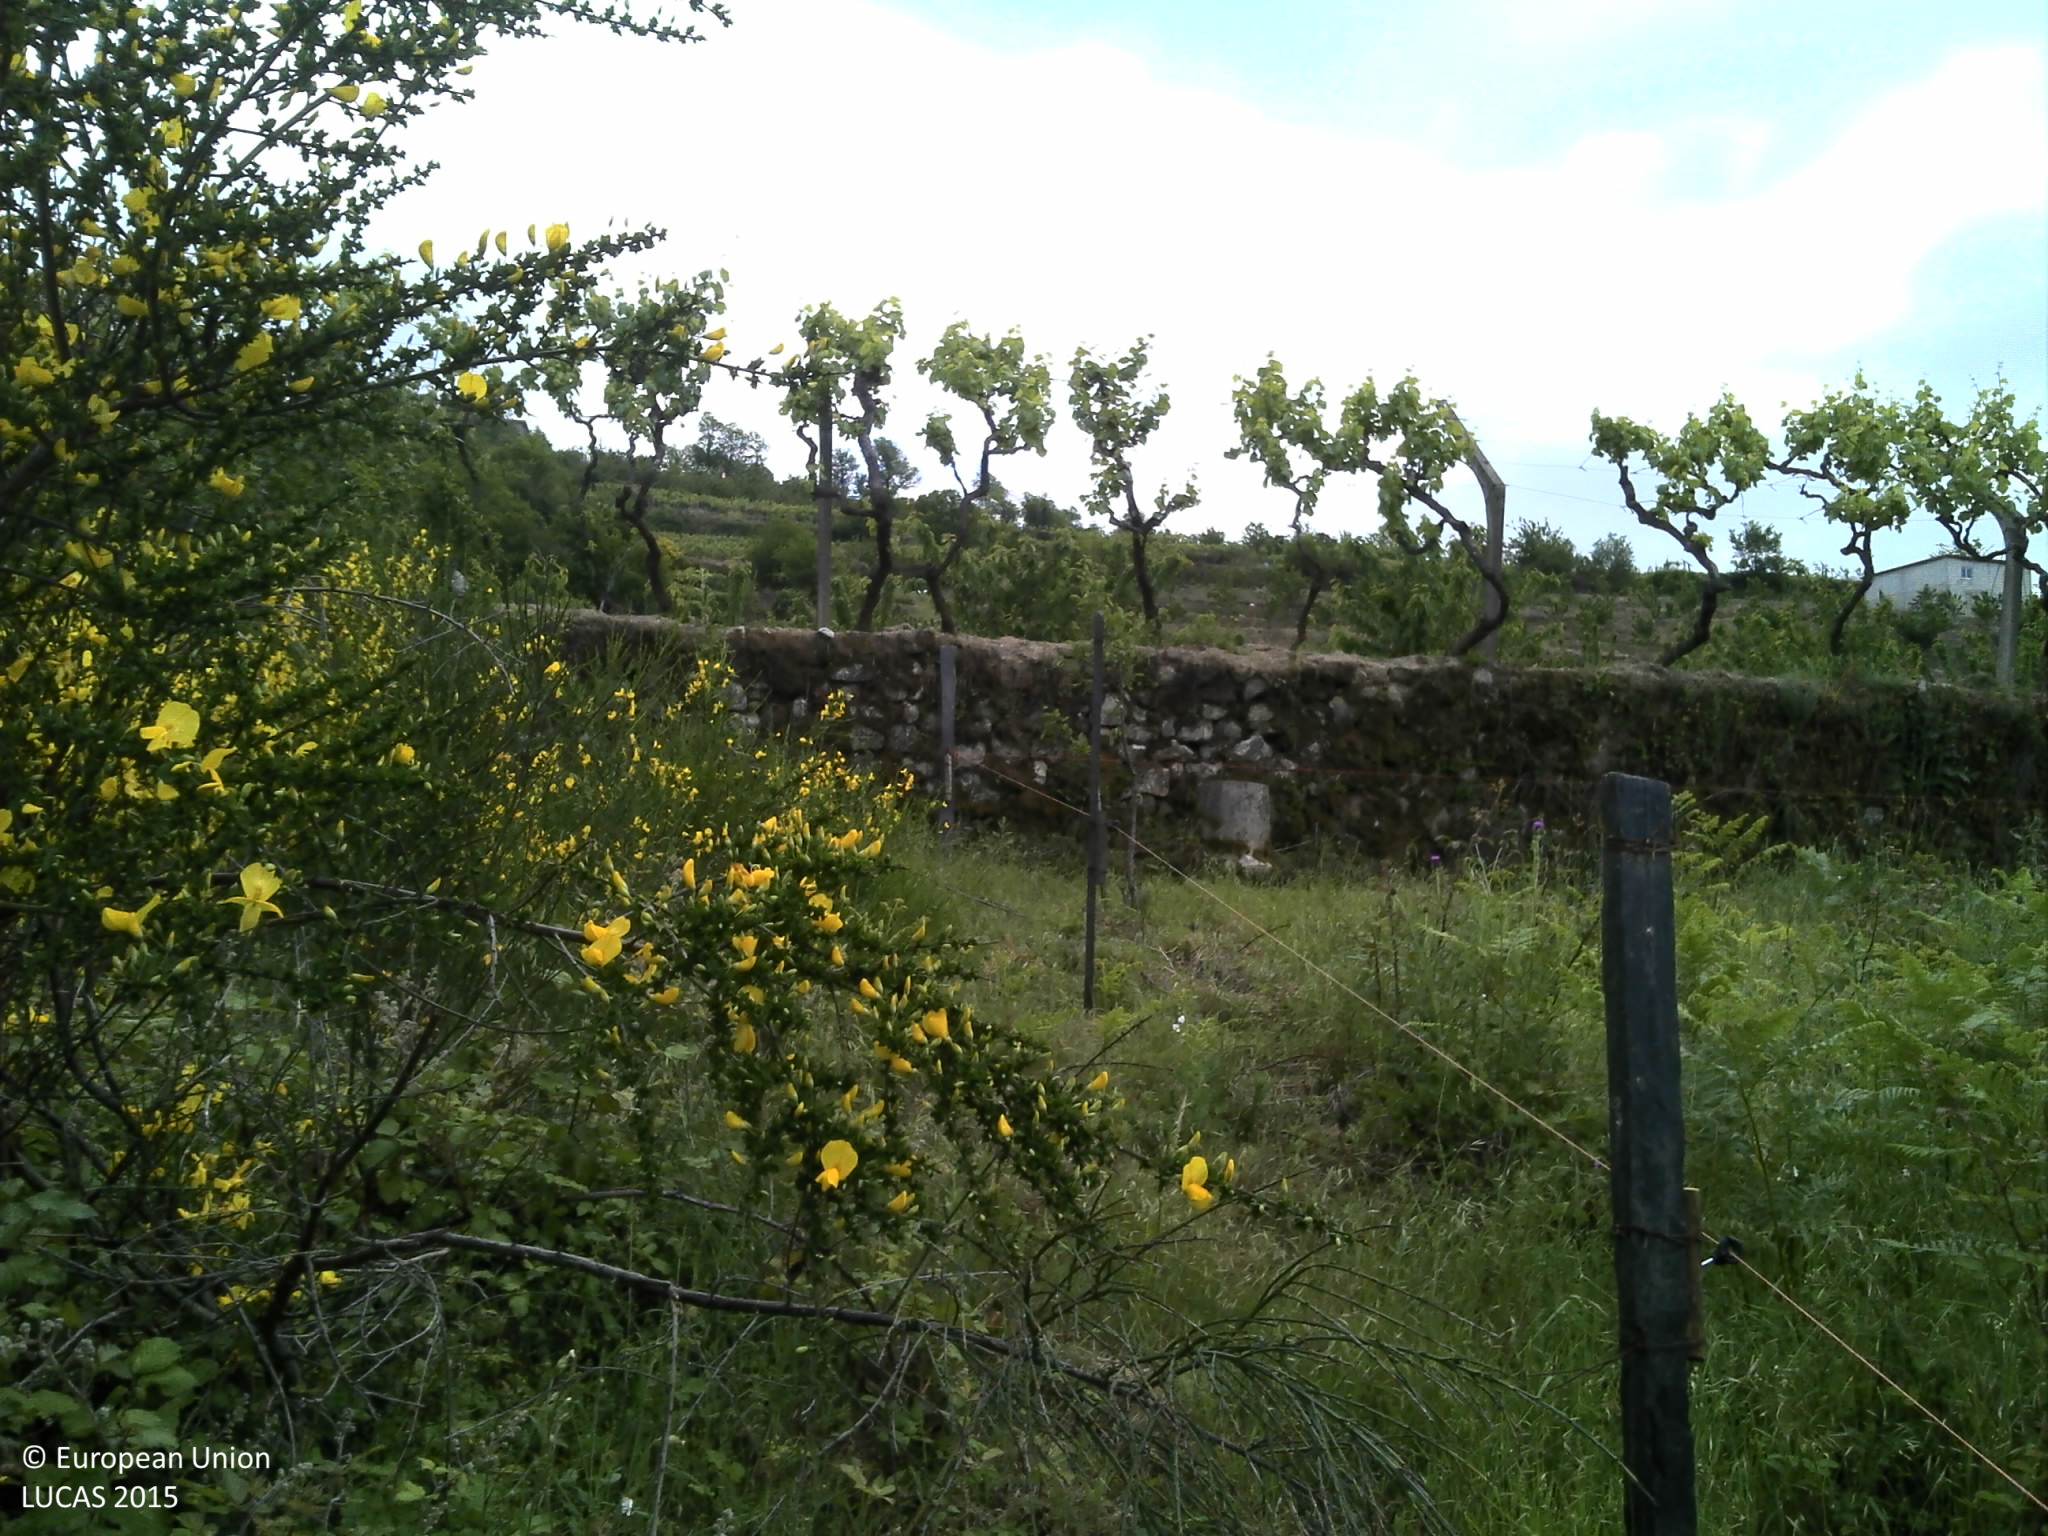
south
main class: Shrubland
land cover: Shrubland without tree cover
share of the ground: > 75 %
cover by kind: shrubs 90 %, herbaceous plants 5 %, unconsolidated bare surface 5 %
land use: Abandoned areas
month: May
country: PT
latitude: 41.0937
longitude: -7.9308
